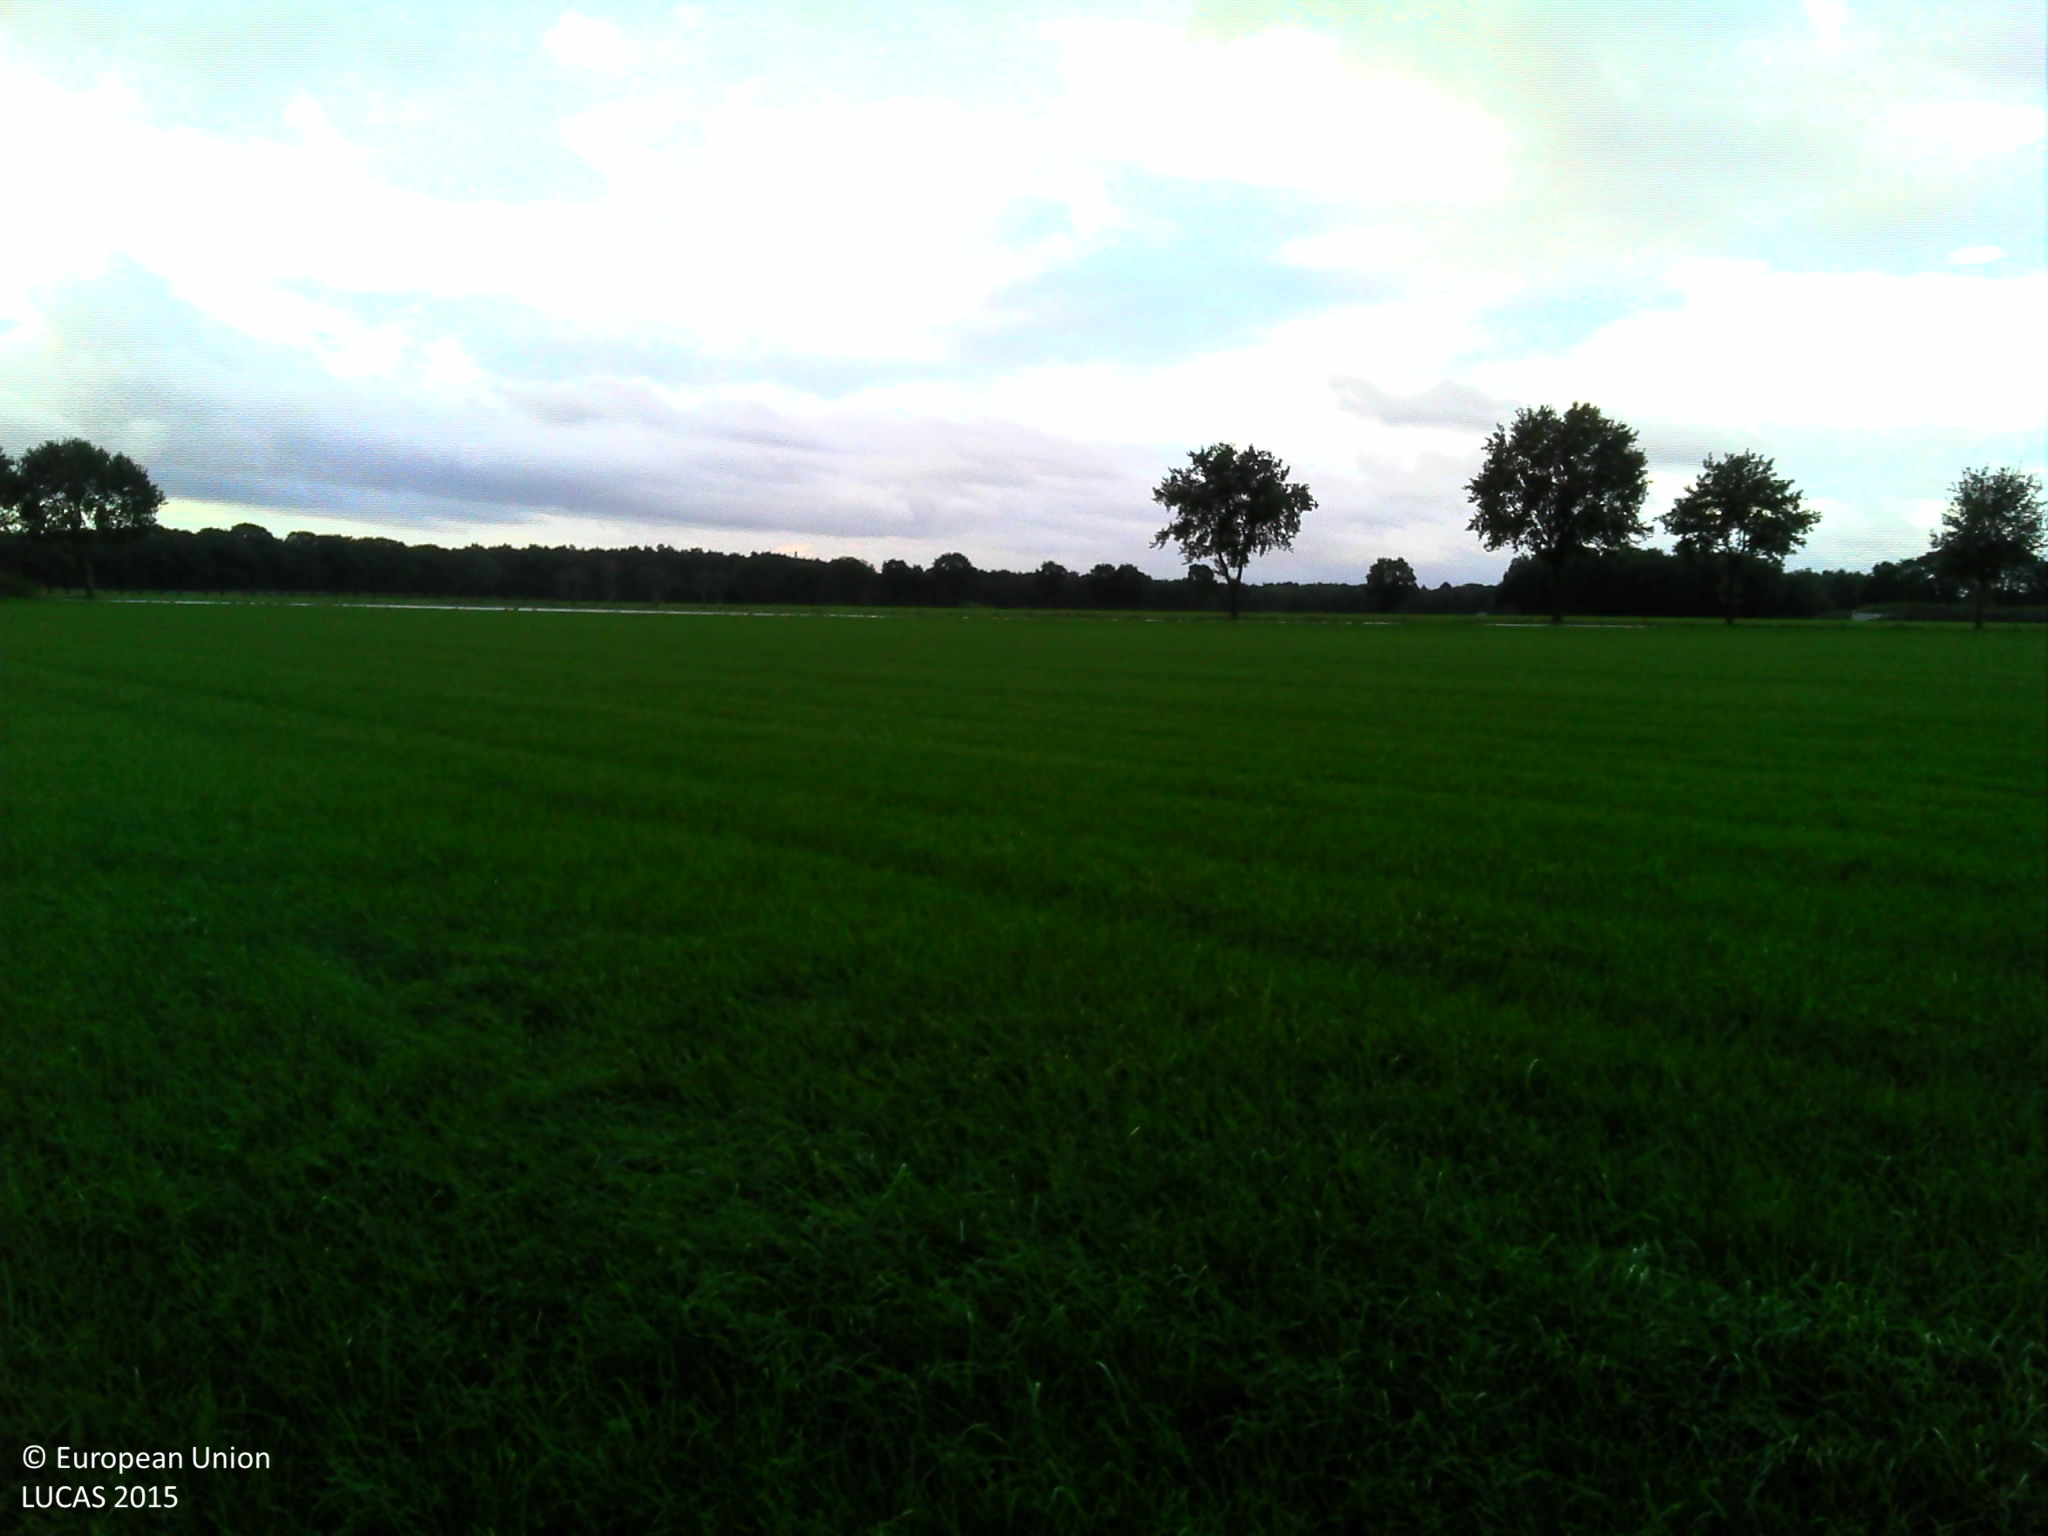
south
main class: Cropland
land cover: Temporary grasslands
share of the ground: > 75 %
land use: Agriculture (excluding fallow land and kitchen gardens)
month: September
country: BE
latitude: 51.3351
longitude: 4.5847
